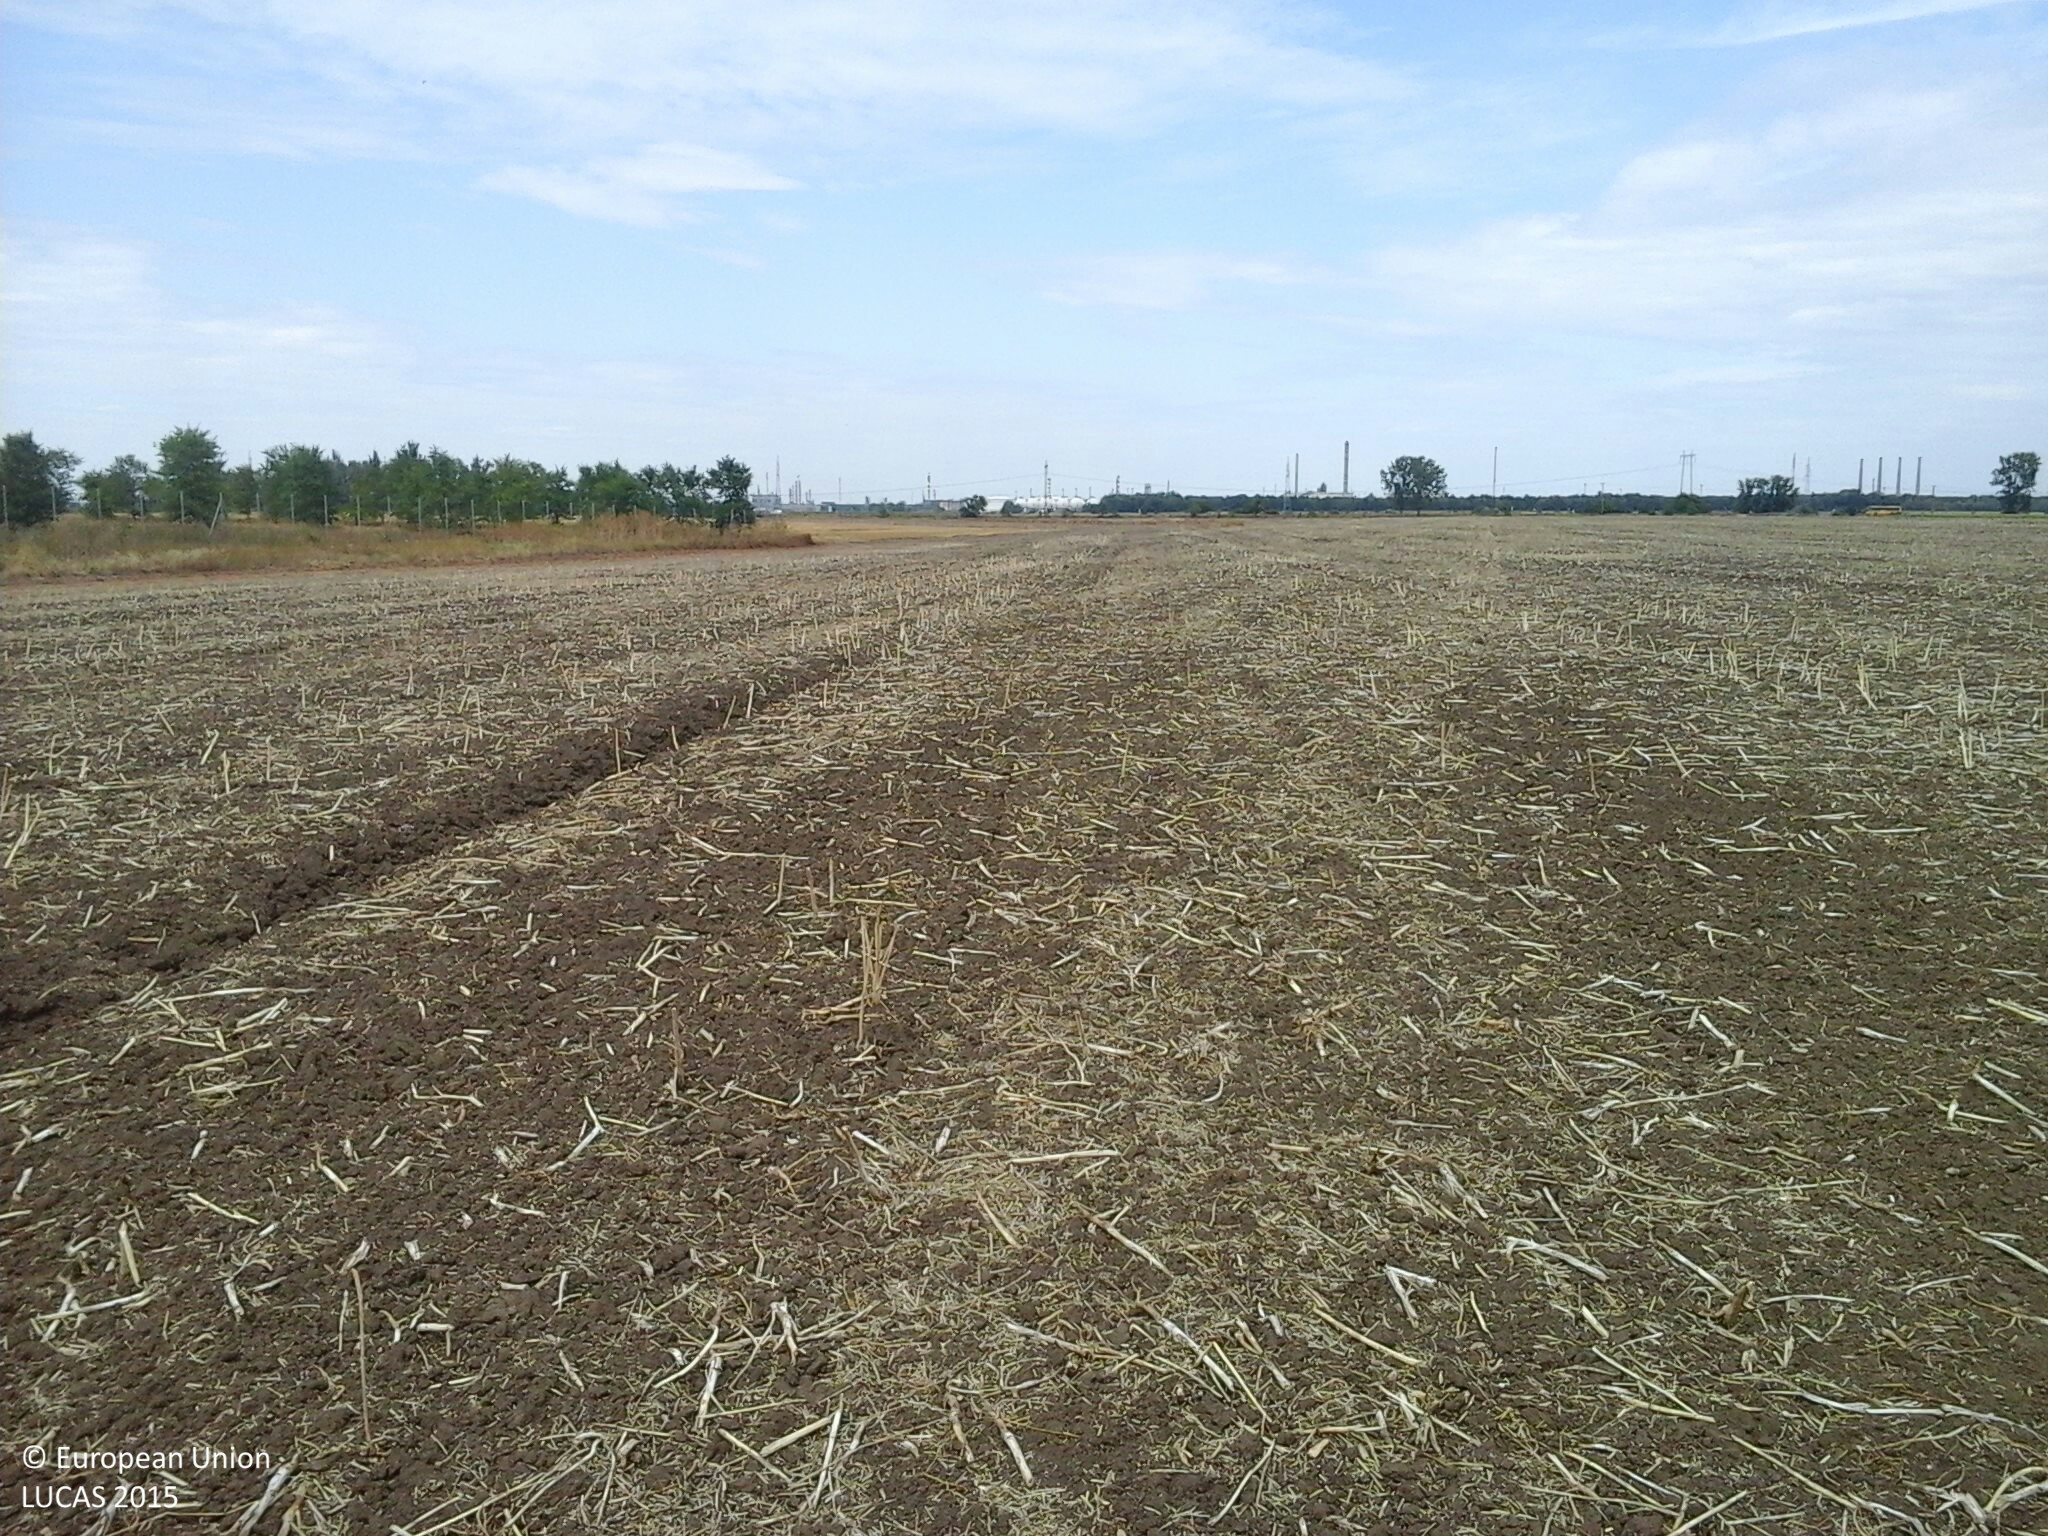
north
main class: Cropland
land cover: Rape and turnip rape
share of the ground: 25 - 50 %
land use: Agriculture (excluding fallow land and kitchen gardens)
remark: Harvested field
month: July
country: HU
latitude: 47.8696
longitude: 21.0144
